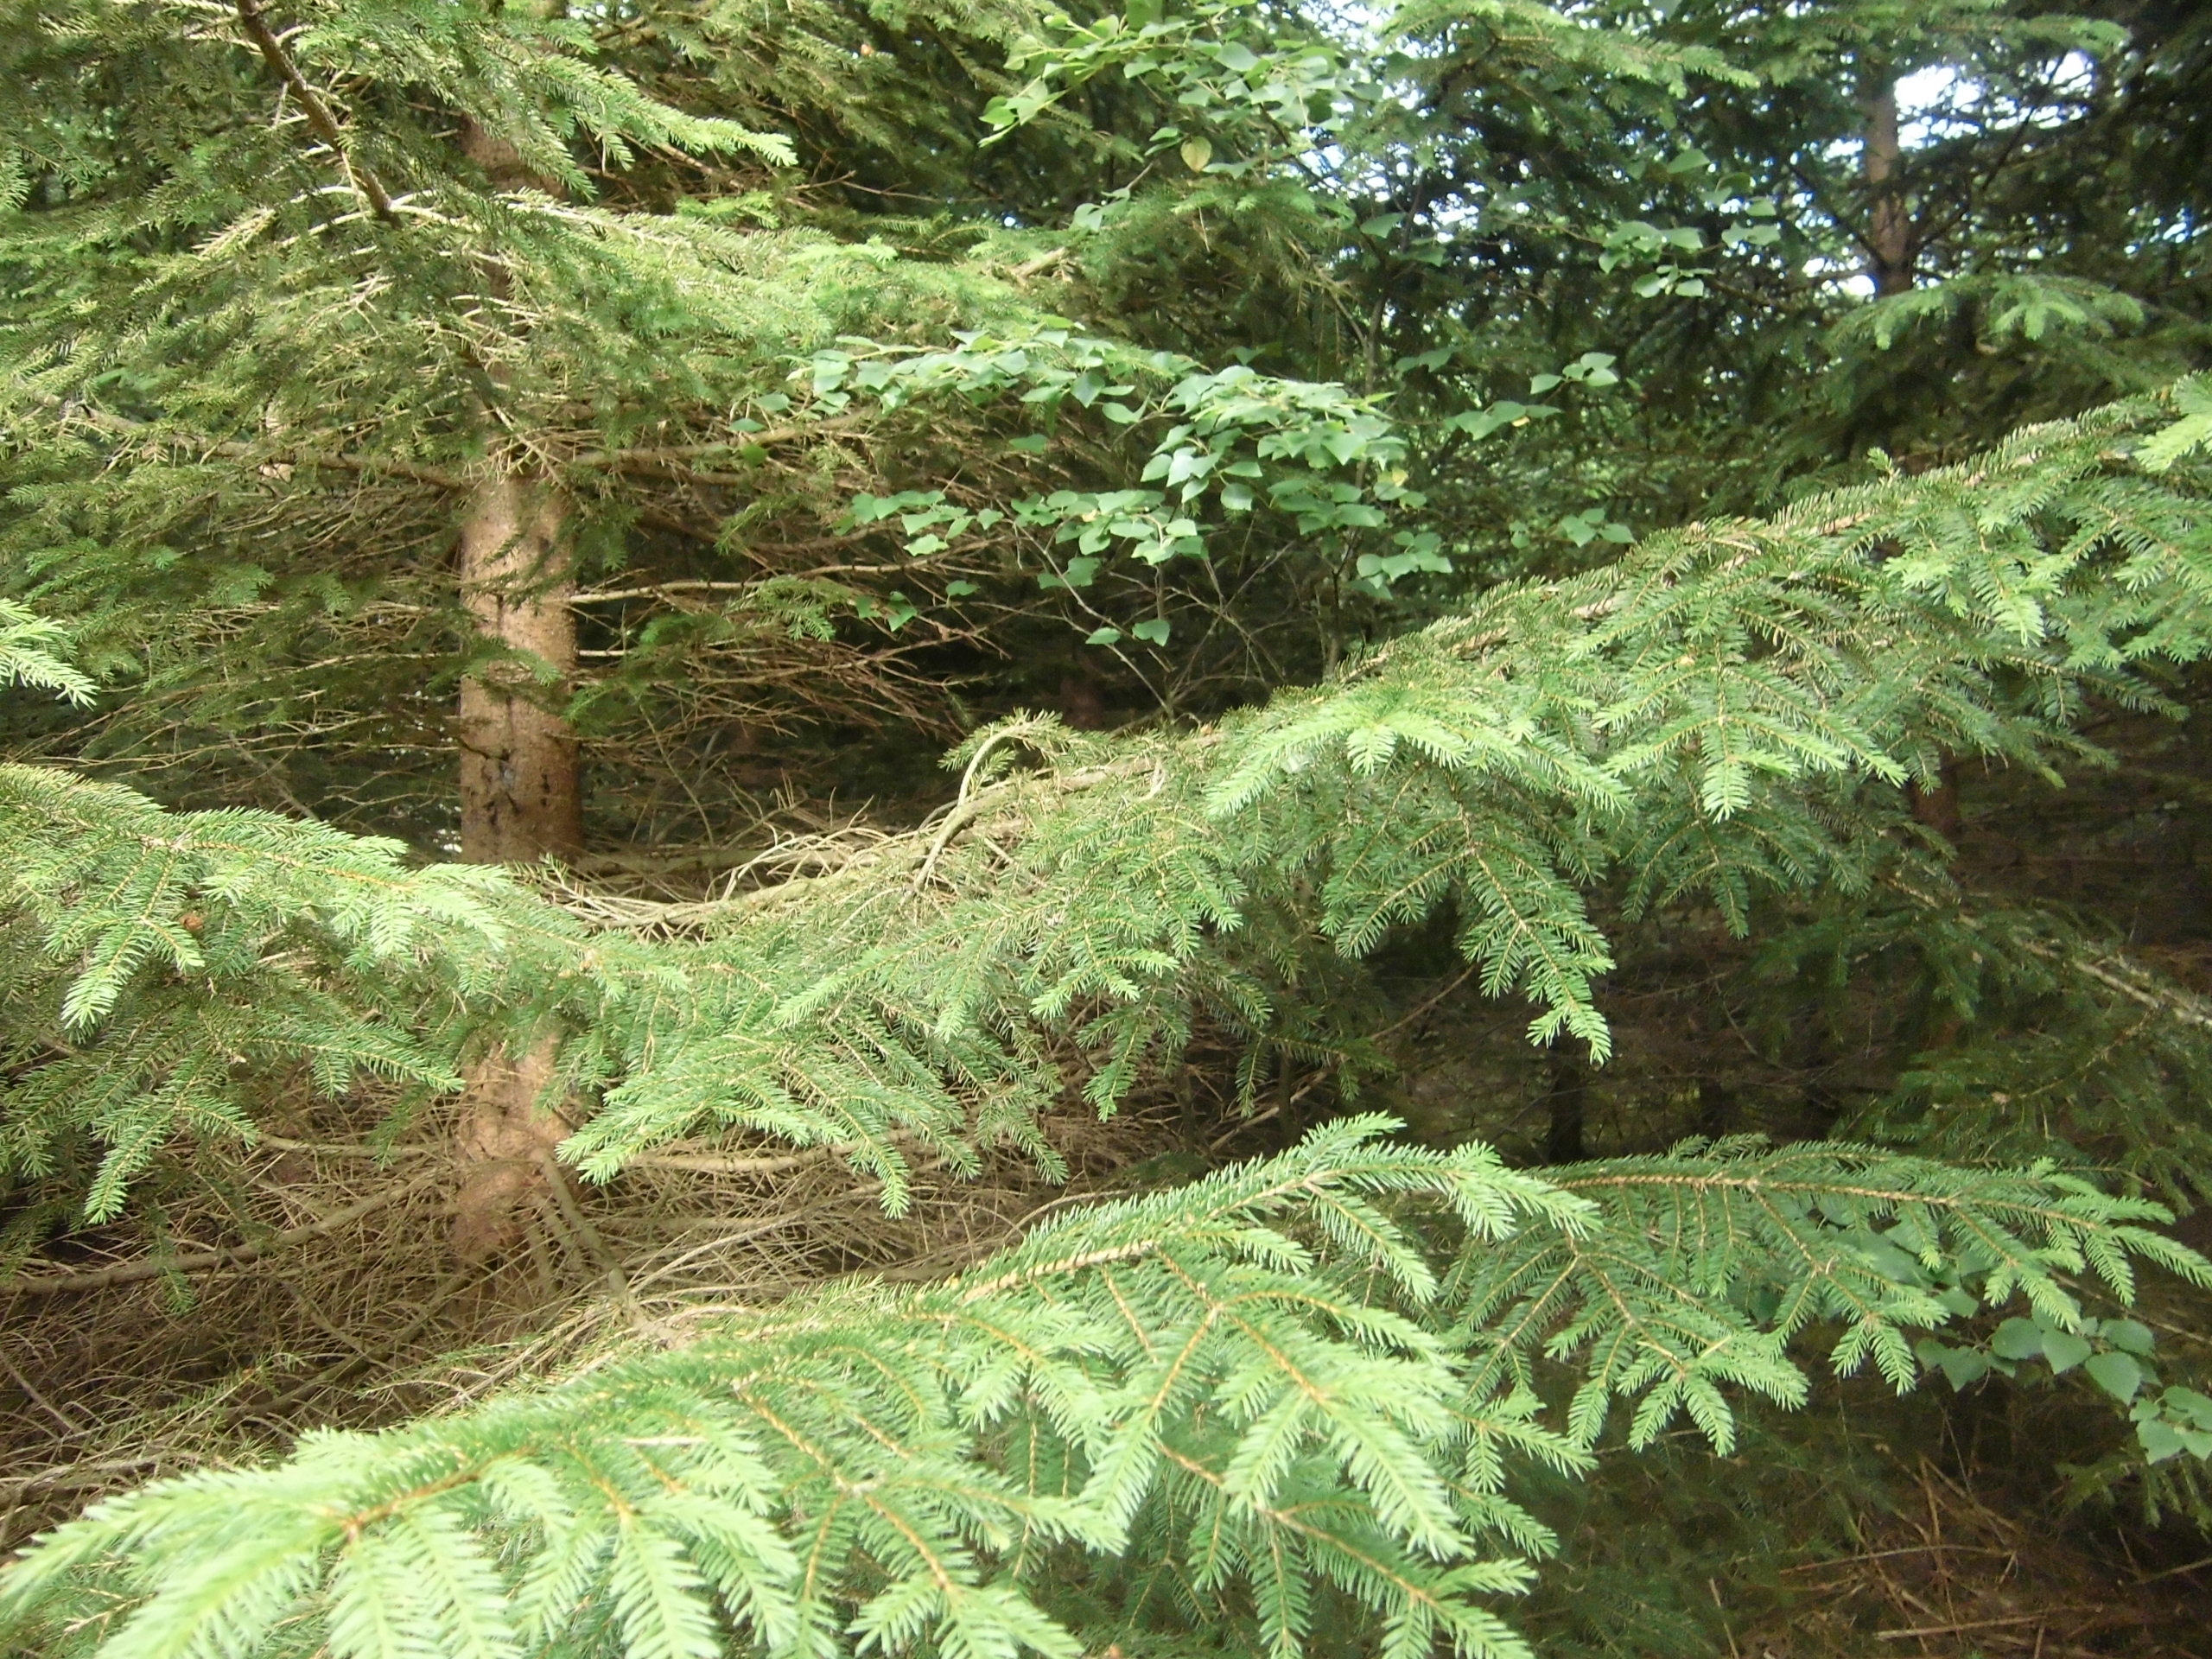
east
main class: Woodland
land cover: Spruce dominated coniferous woodland
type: boreal forest
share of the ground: > 75 %
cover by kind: coniferous forest trees 75 %, lichens and mosses 15 %, broadleaved forest trees 5 %, herbaceous plants 5 %
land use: Forestry
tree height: > 5 m
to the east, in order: Spruce dominated coniferous woodland; Spruce dominated mixed woodland; Paved roads, cycling and walking lanes; Spruce dominated coniferous woodland; Spruce dominated mixed woodland; Spruce dominated coniferous woodland; Grassland with sparse tree/shrub cover; Spruce dominated coniferous woodland
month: July
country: SE
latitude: 57.2465
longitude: 14.9186
